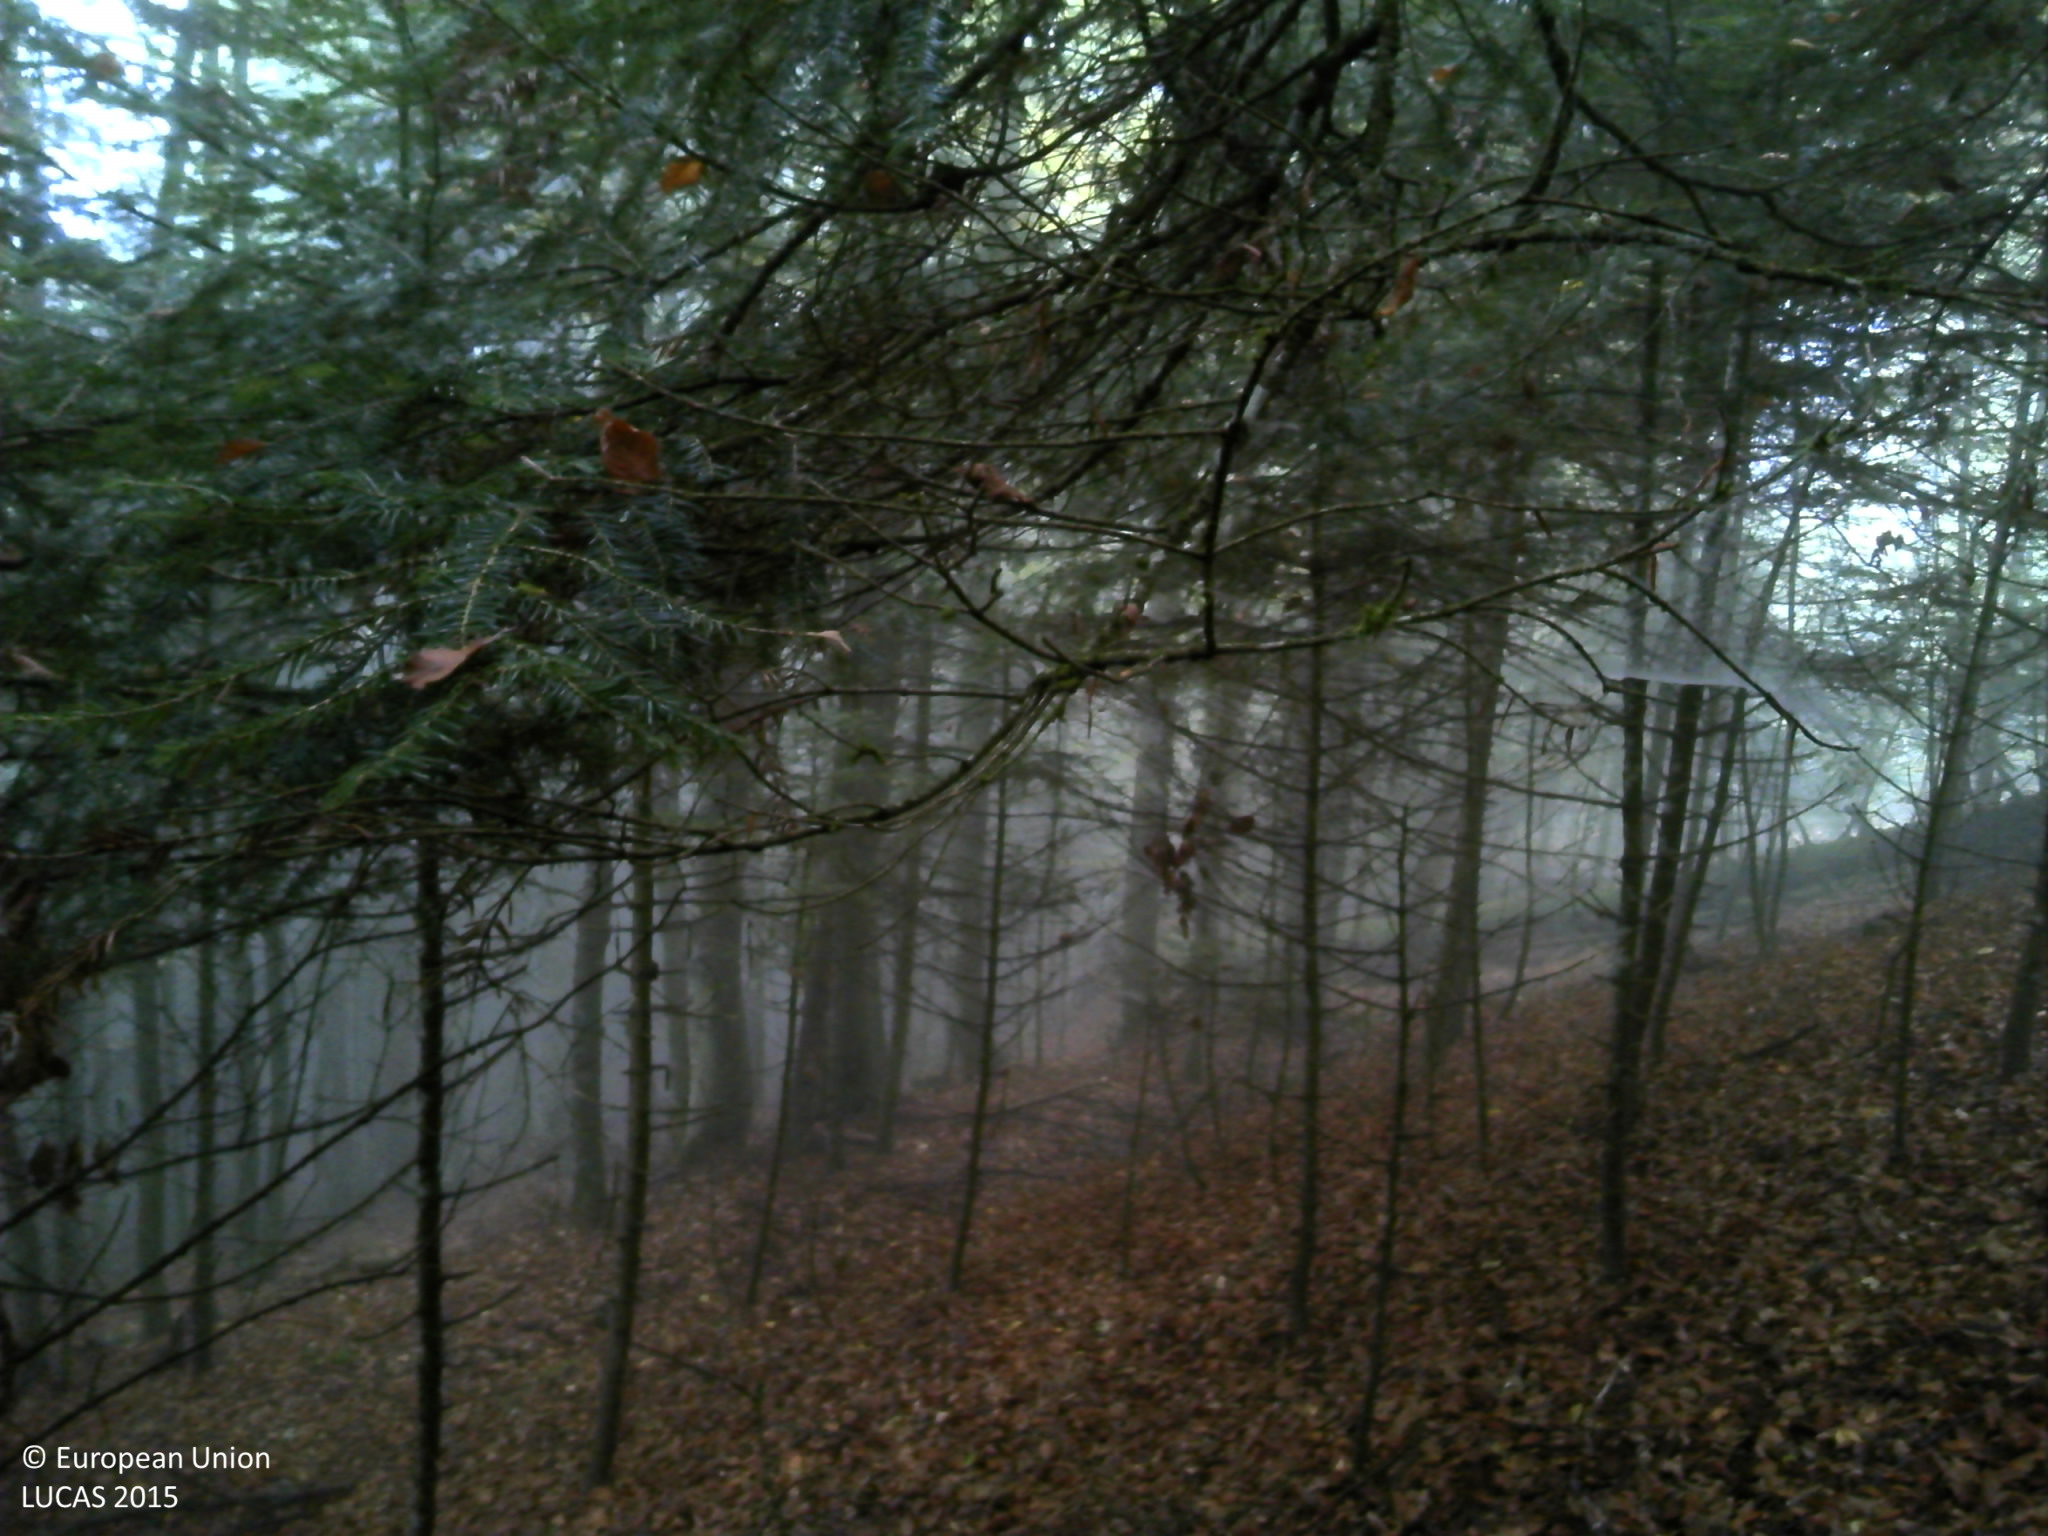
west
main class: Woodland
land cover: Spruce dominated mixed woodland
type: mountainous beech forest
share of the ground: > 75 %
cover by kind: broadleaved forest trees 50 %, coniferous forest trees 40 %, unconsolidated bare surface 10 %
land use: Forestry
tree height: > 5 m
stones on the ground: < 10 %
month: October
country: FR
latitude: 45.6447
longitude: 3.7535
